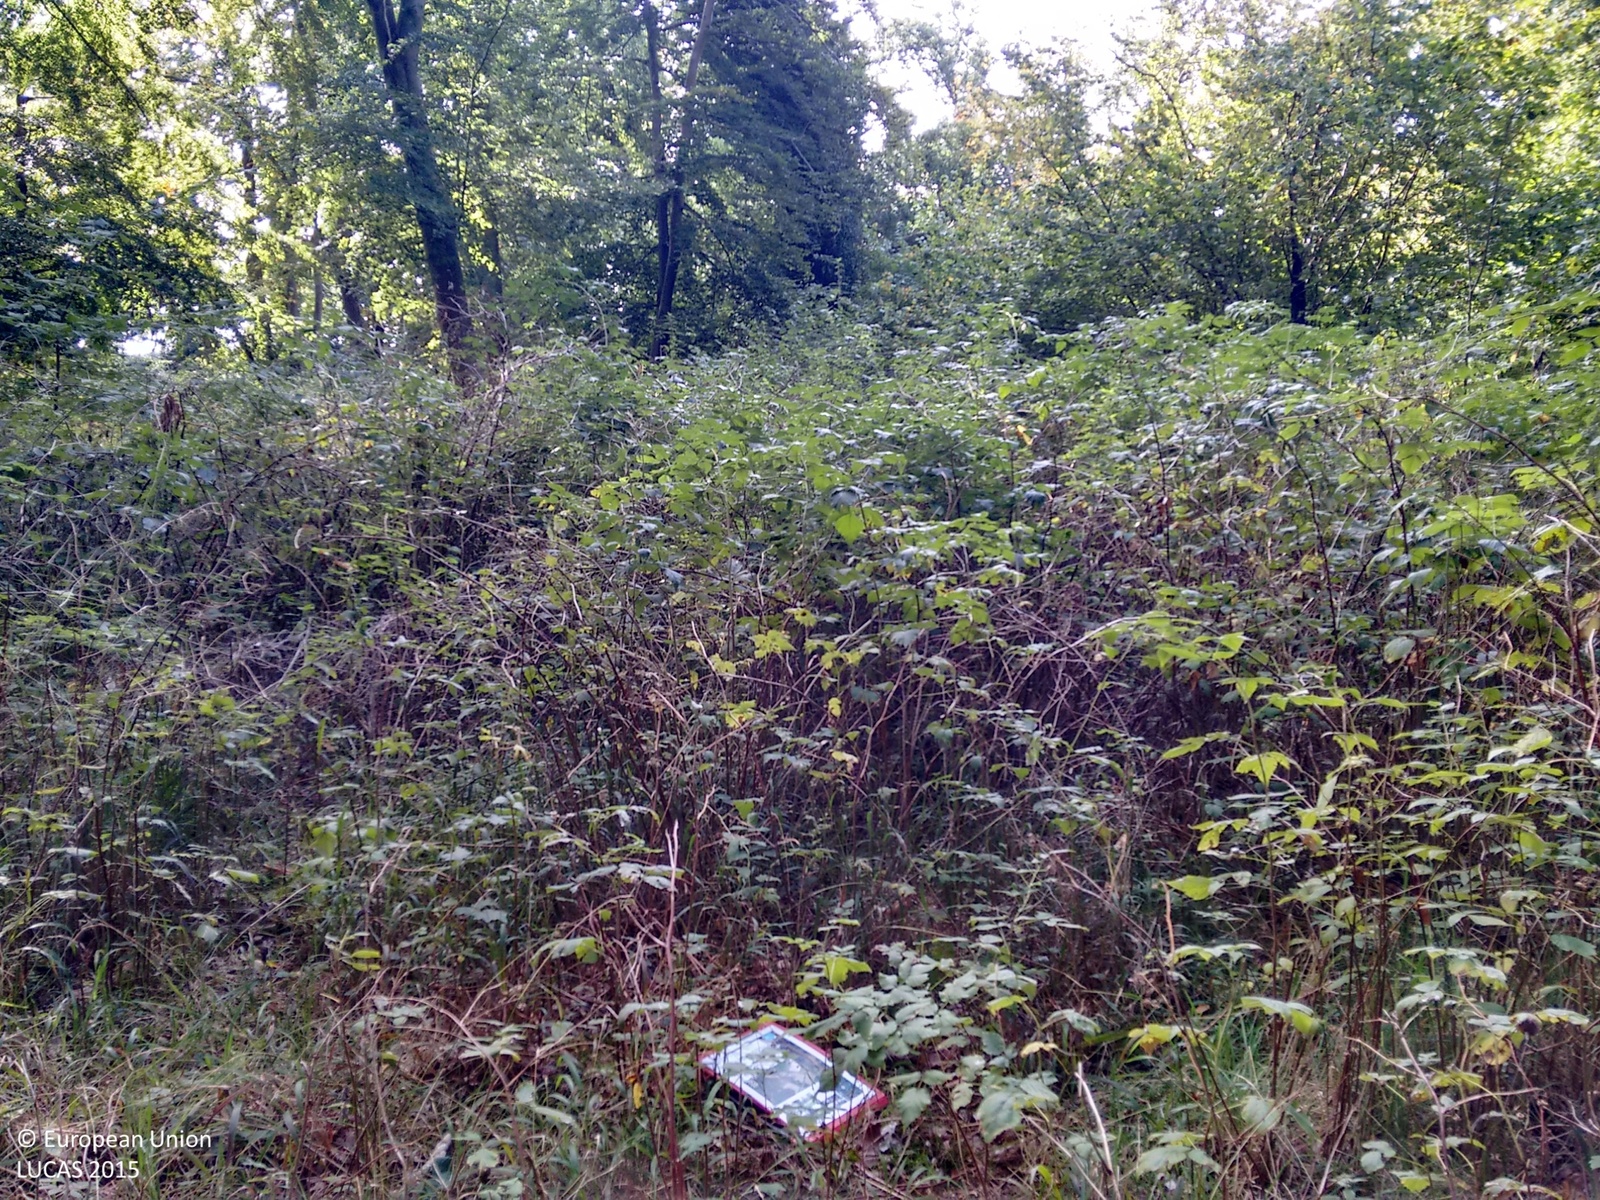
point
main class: Woodland
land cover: Broadleaved woodland
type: mesophytic deciduous forest
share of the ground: > 75 %
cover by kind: broadleaved forest trees 100 %
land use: Forestry
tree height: > 5 m
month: September
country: GB
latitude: 52.4256
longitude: 0.9025
